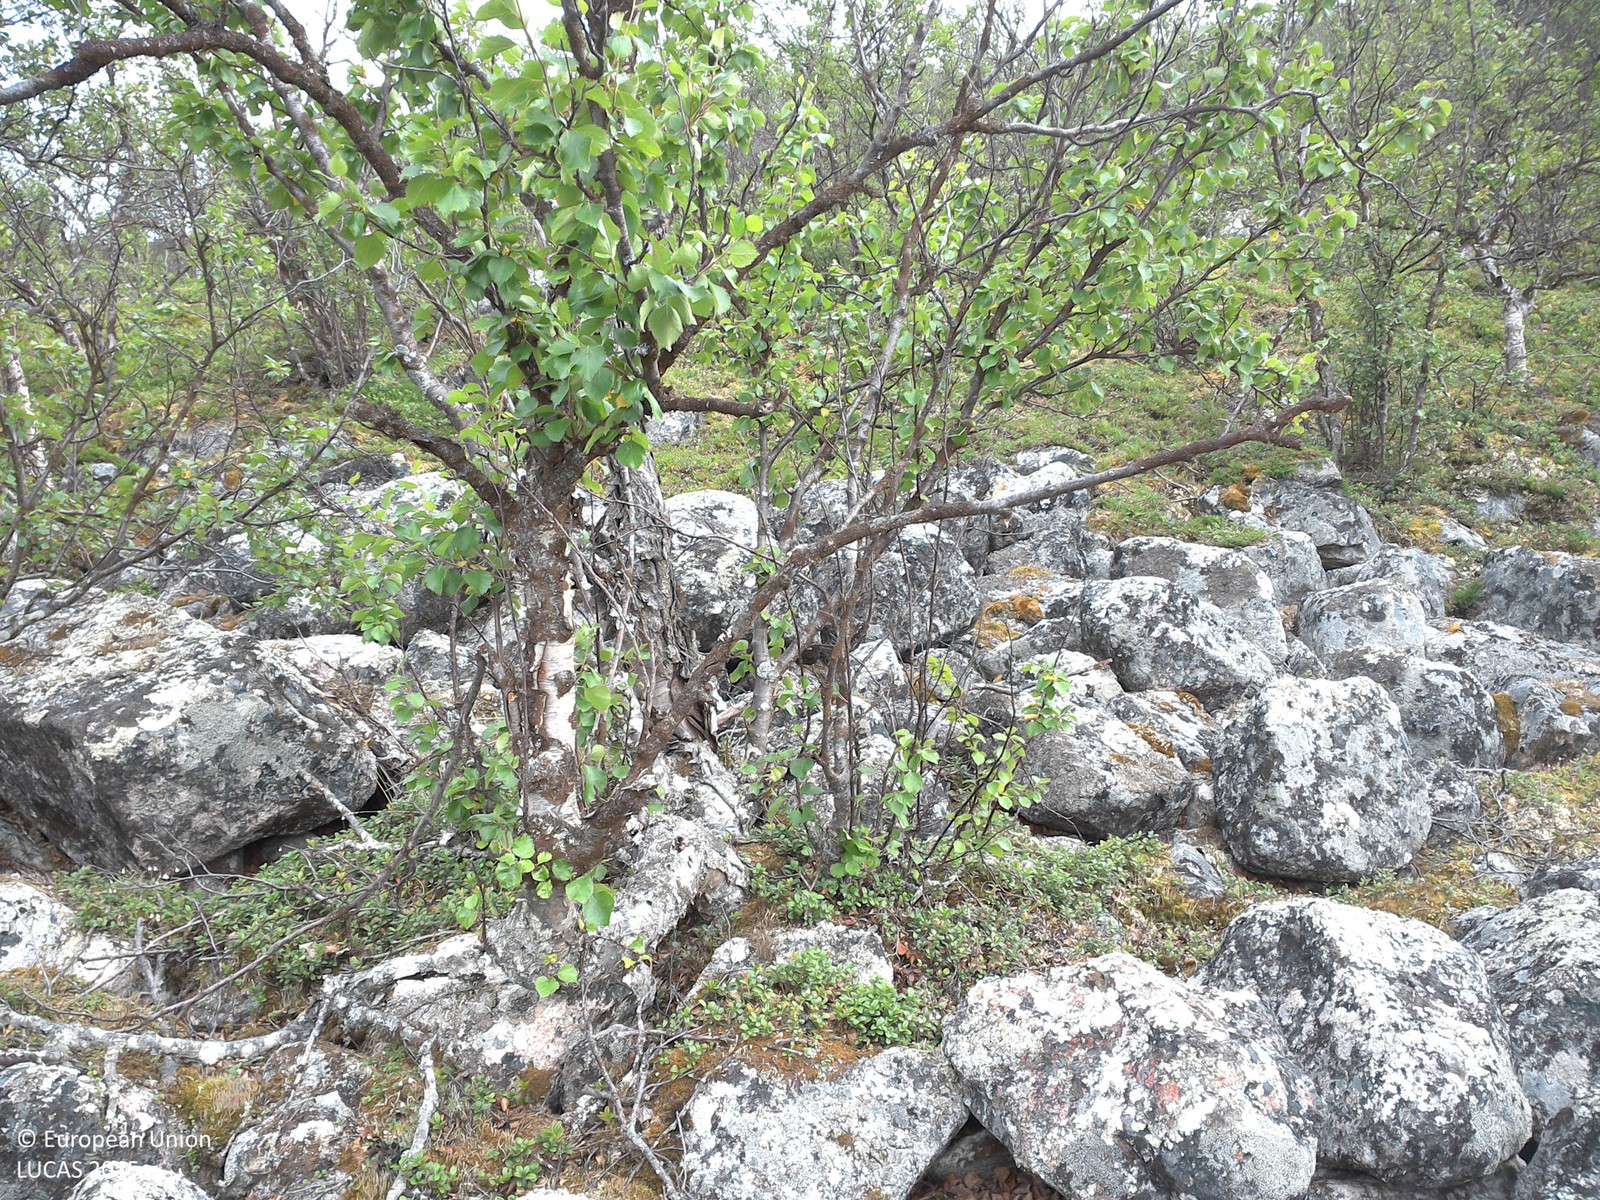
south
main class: Woodland
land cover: Broadleaved woodland
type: boreal forest
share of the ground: 10 - 25 %
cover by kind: shrubs 60 %, broadleaved forest trees 20 %, lichens and mosses 20 %
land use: Forestry
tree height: < 5 m
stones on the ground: > 50 %
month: August
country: SE
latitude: 68.2360
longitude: 19.5276
